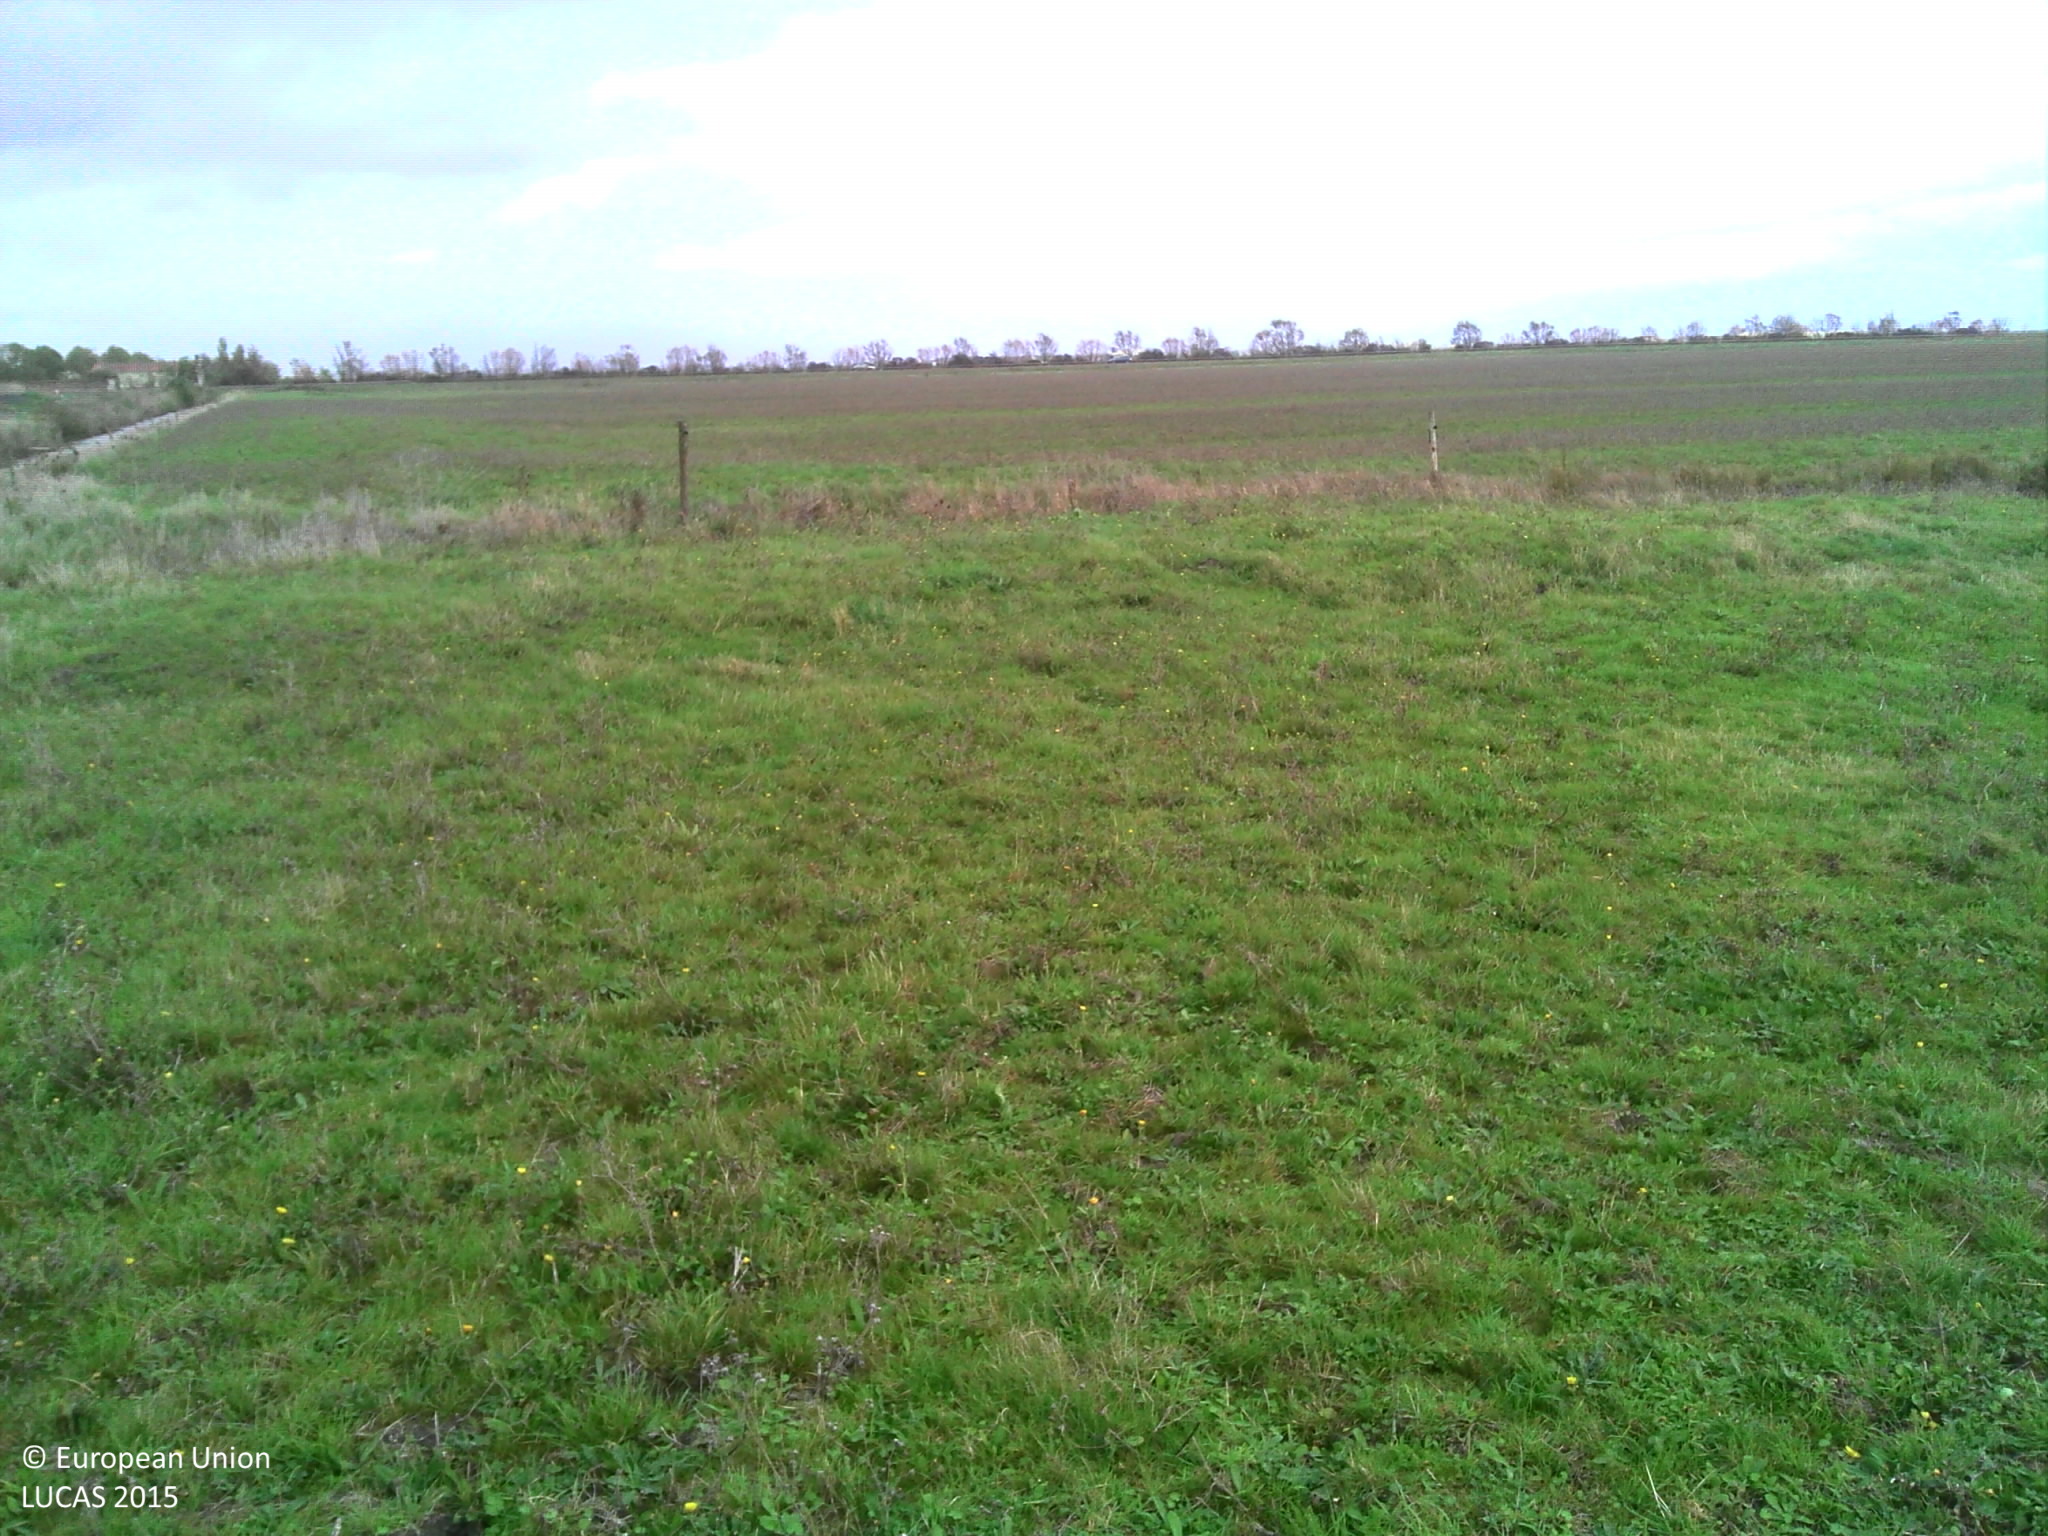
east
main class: Grassland
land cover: Grassland without tree/shrub cover
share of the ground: > 75 %
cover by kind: herbaceous plants 100 %
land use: Agriculture (excluding fallow land and kitchen gardens)
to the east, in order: Grassland without tree/shrub cover; Fences; Ditches and canals; Grassland without tree/shrub cover; Ditches and canals; Grassland without tree/shrub cover
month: October
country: FR
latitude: 46.4074
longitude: -1.1026
